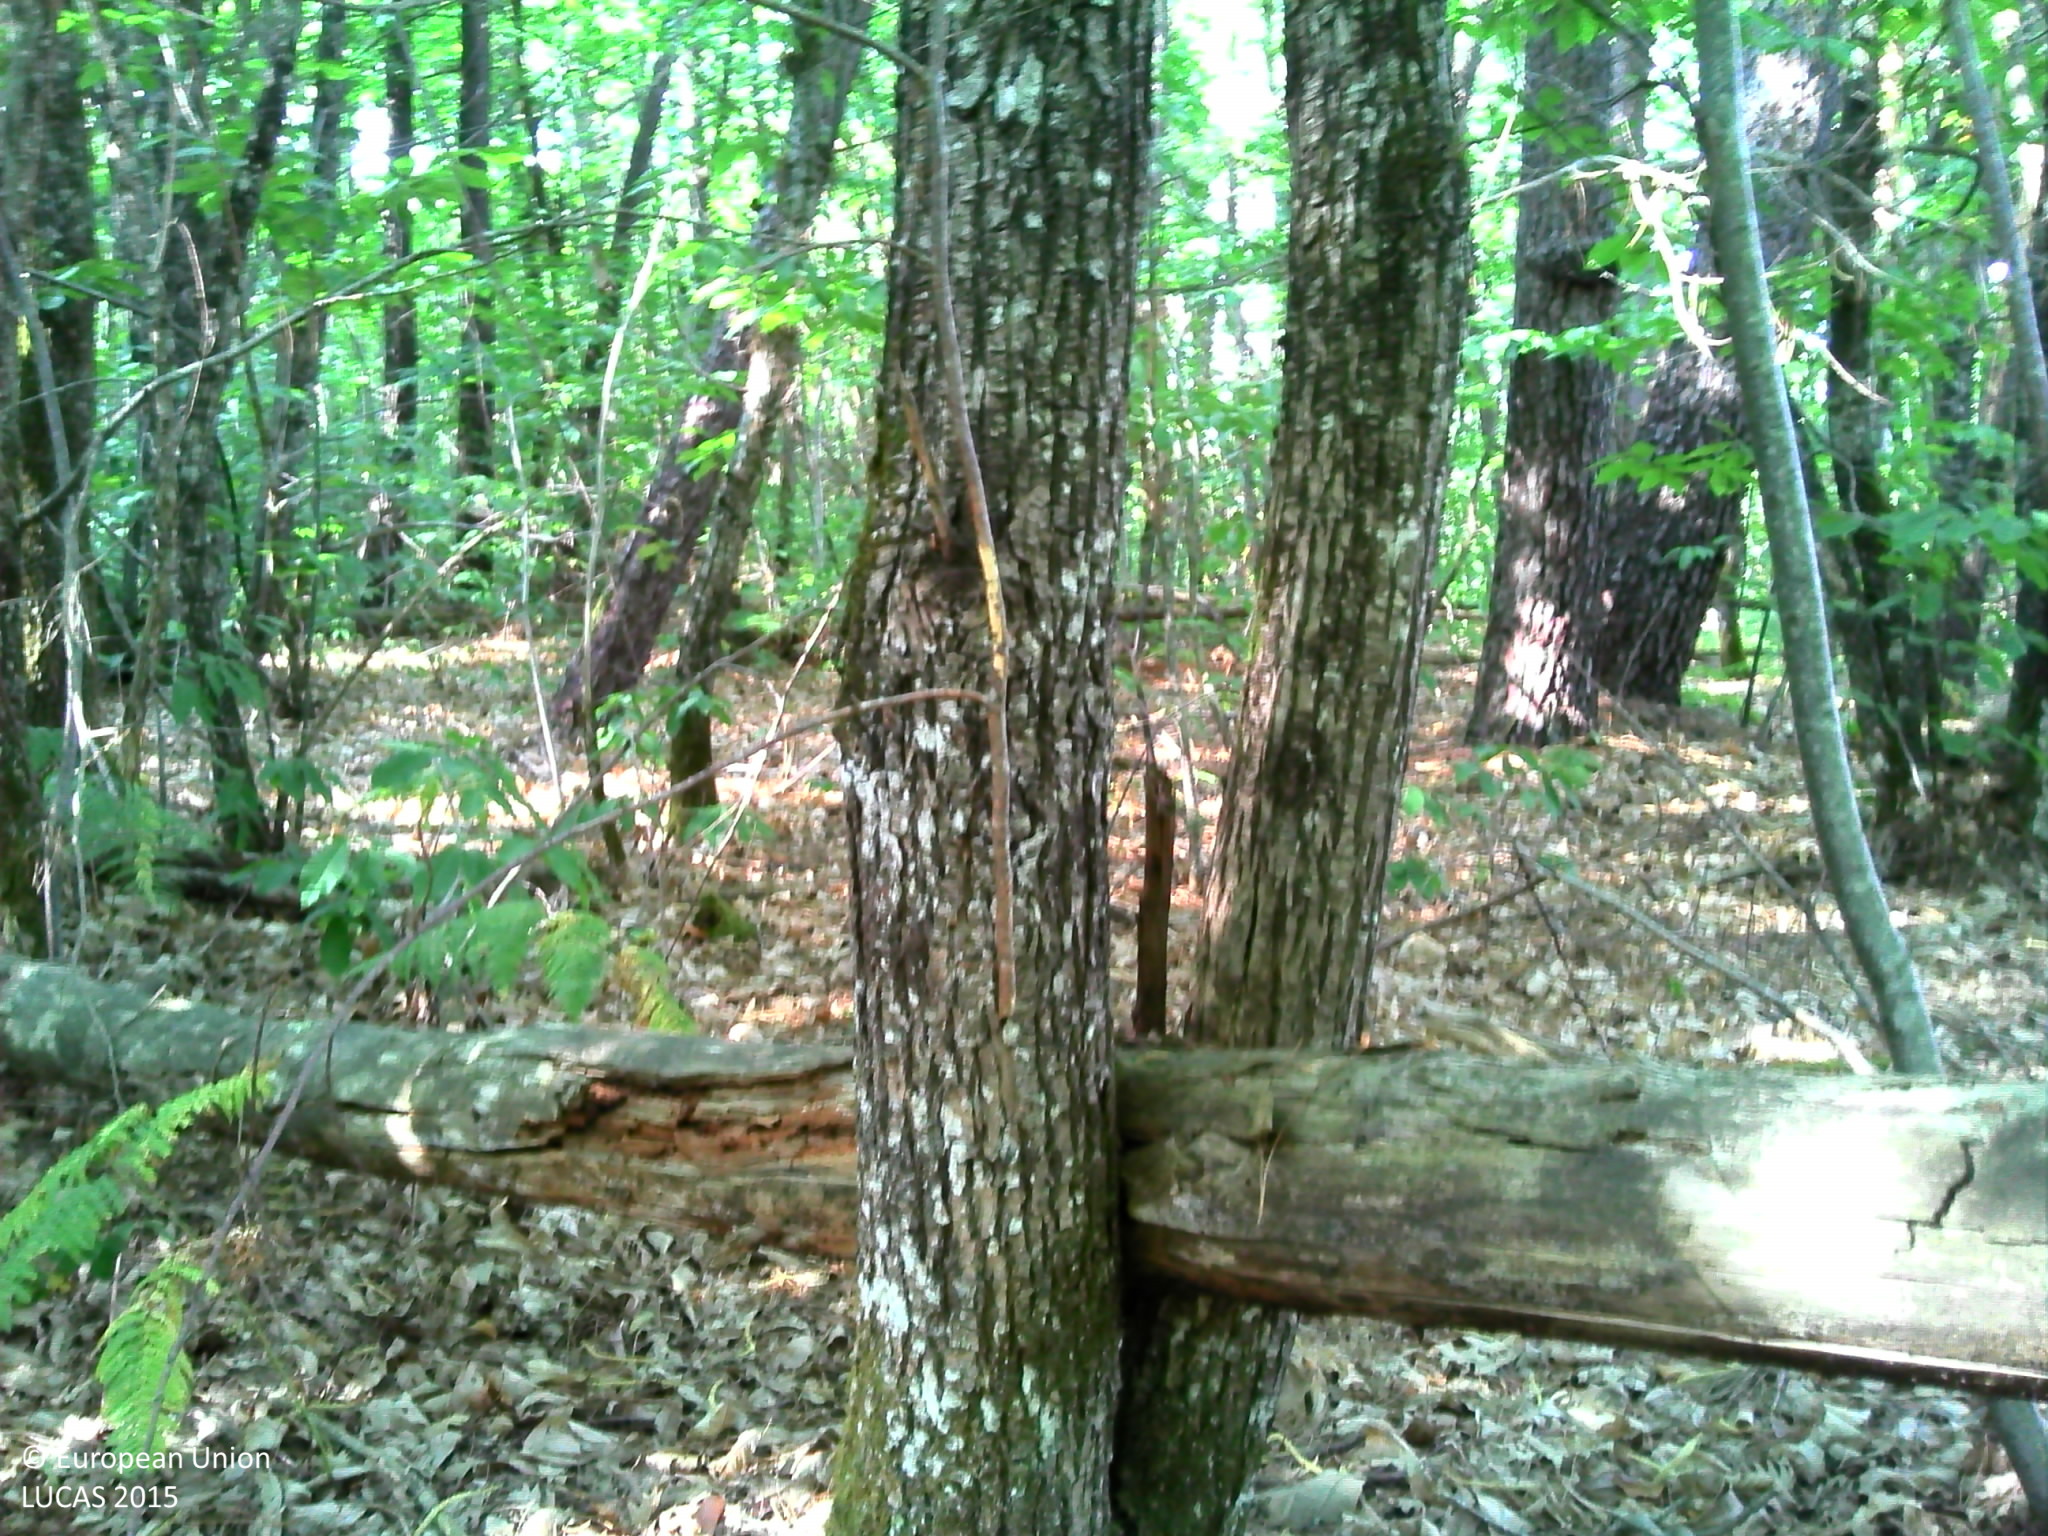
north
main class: Woodland
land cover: Broadleaved woodland
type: thermophilous deciduous forest
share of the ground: > 75 %
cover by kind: broadleaved forest trees 75 %, herbaceous plants 10 %, shrubs 5 %, lichens and mosses 5 %, unconsolidated bare surface 5 %
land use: Forestry
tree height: > 5 m
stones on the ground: < 10 %
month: July
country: FR
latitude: 45.1468
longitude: 0.8979
